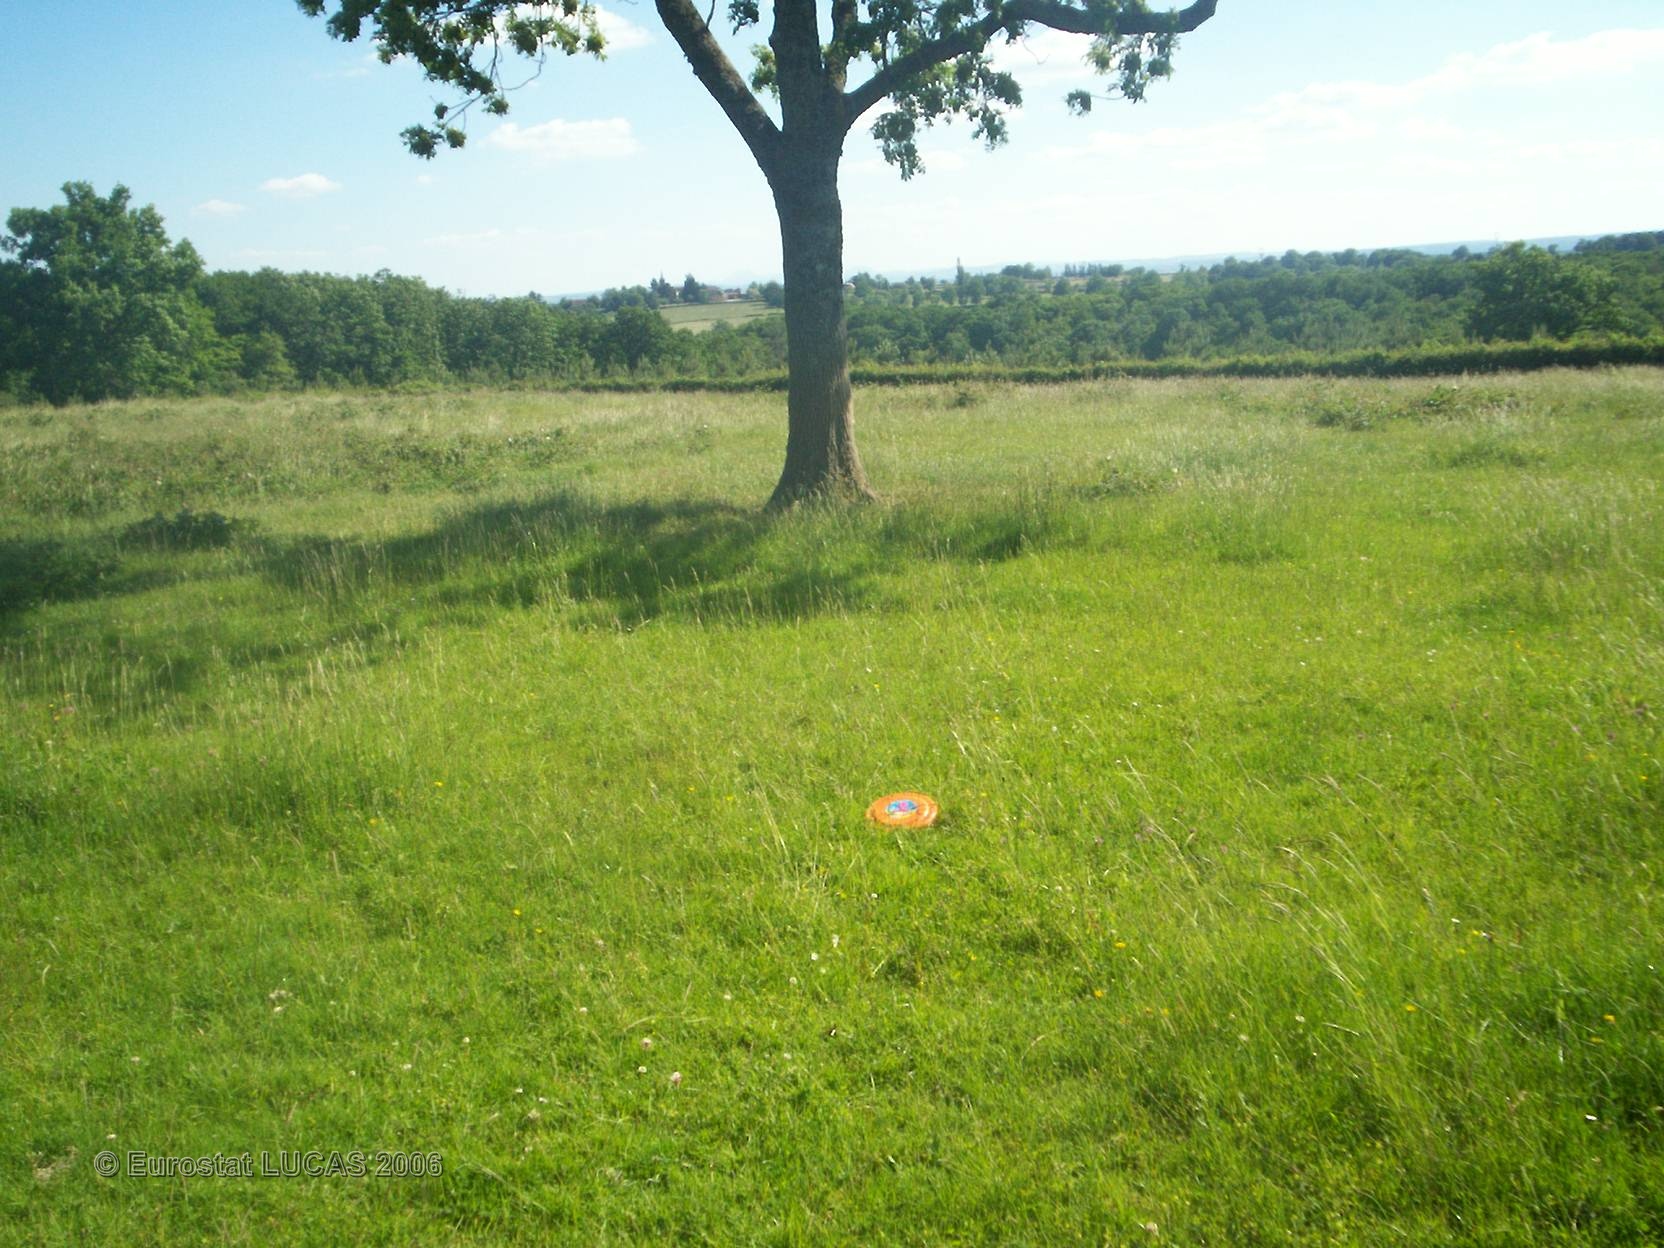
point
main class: Grassland
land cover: Grassland with sparse tree/shrub cover
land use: Agriculture (excluding fallow land and kitchen gardens)
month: June
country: FR
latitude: 46.2963
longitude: 3.1829
